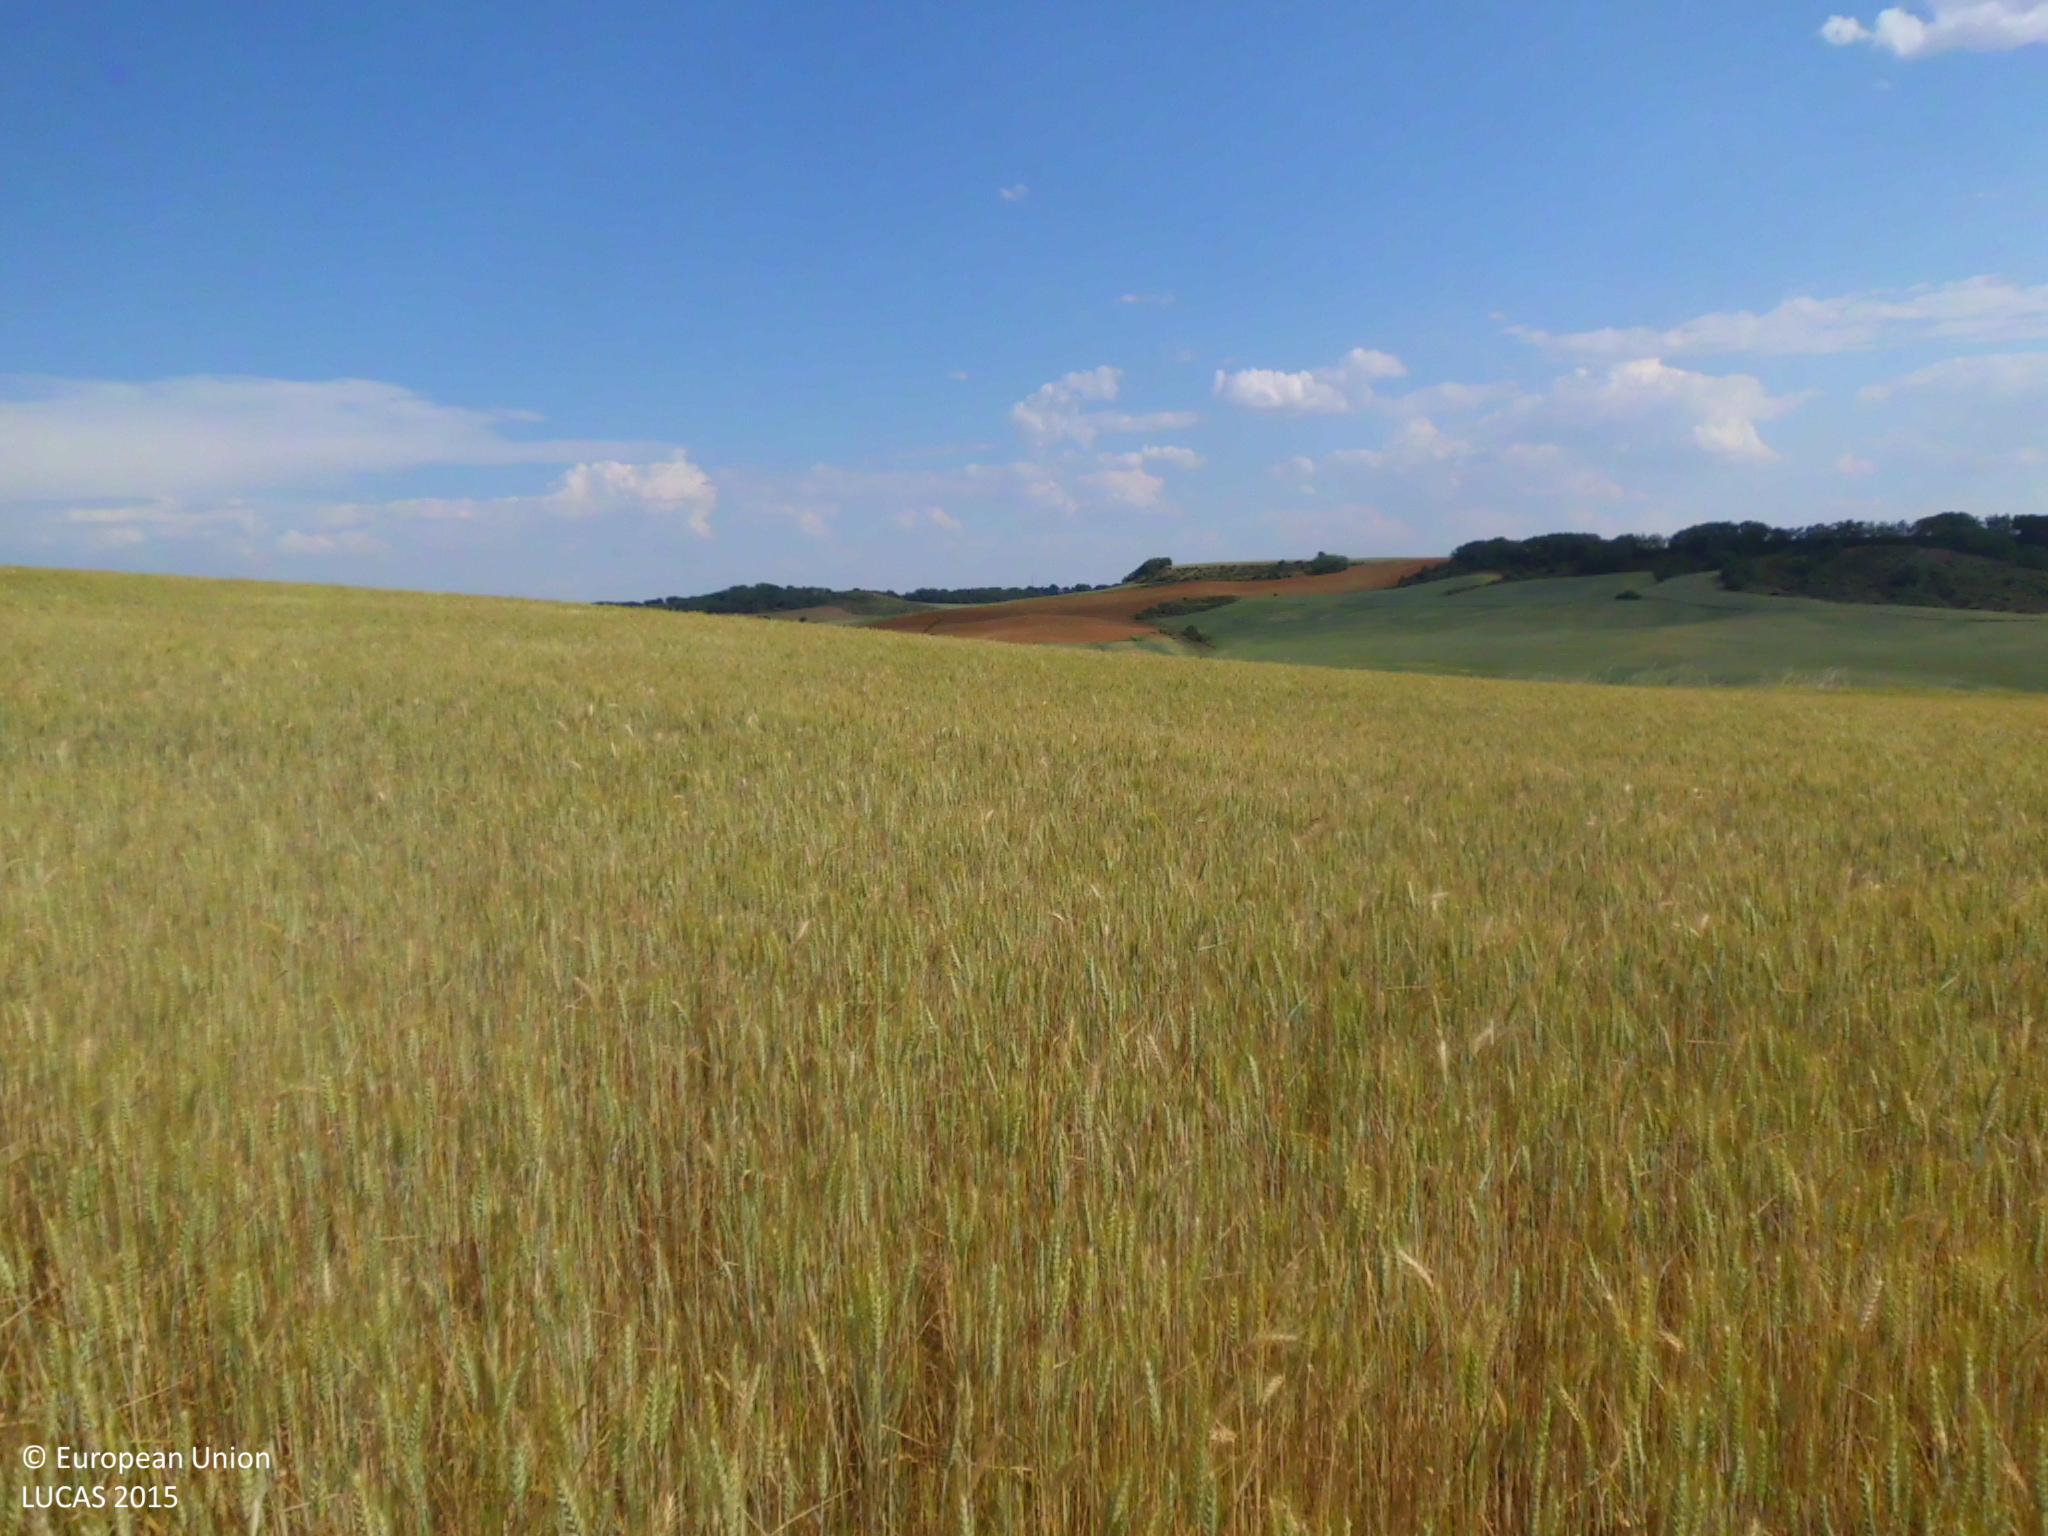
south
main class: Cropland
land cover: Common wheat
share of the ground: > 75 %
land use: Agriculture (excluding fallow land and kitchen gardens)
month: June
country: ES
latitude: 42.4878
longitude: -4.3434
